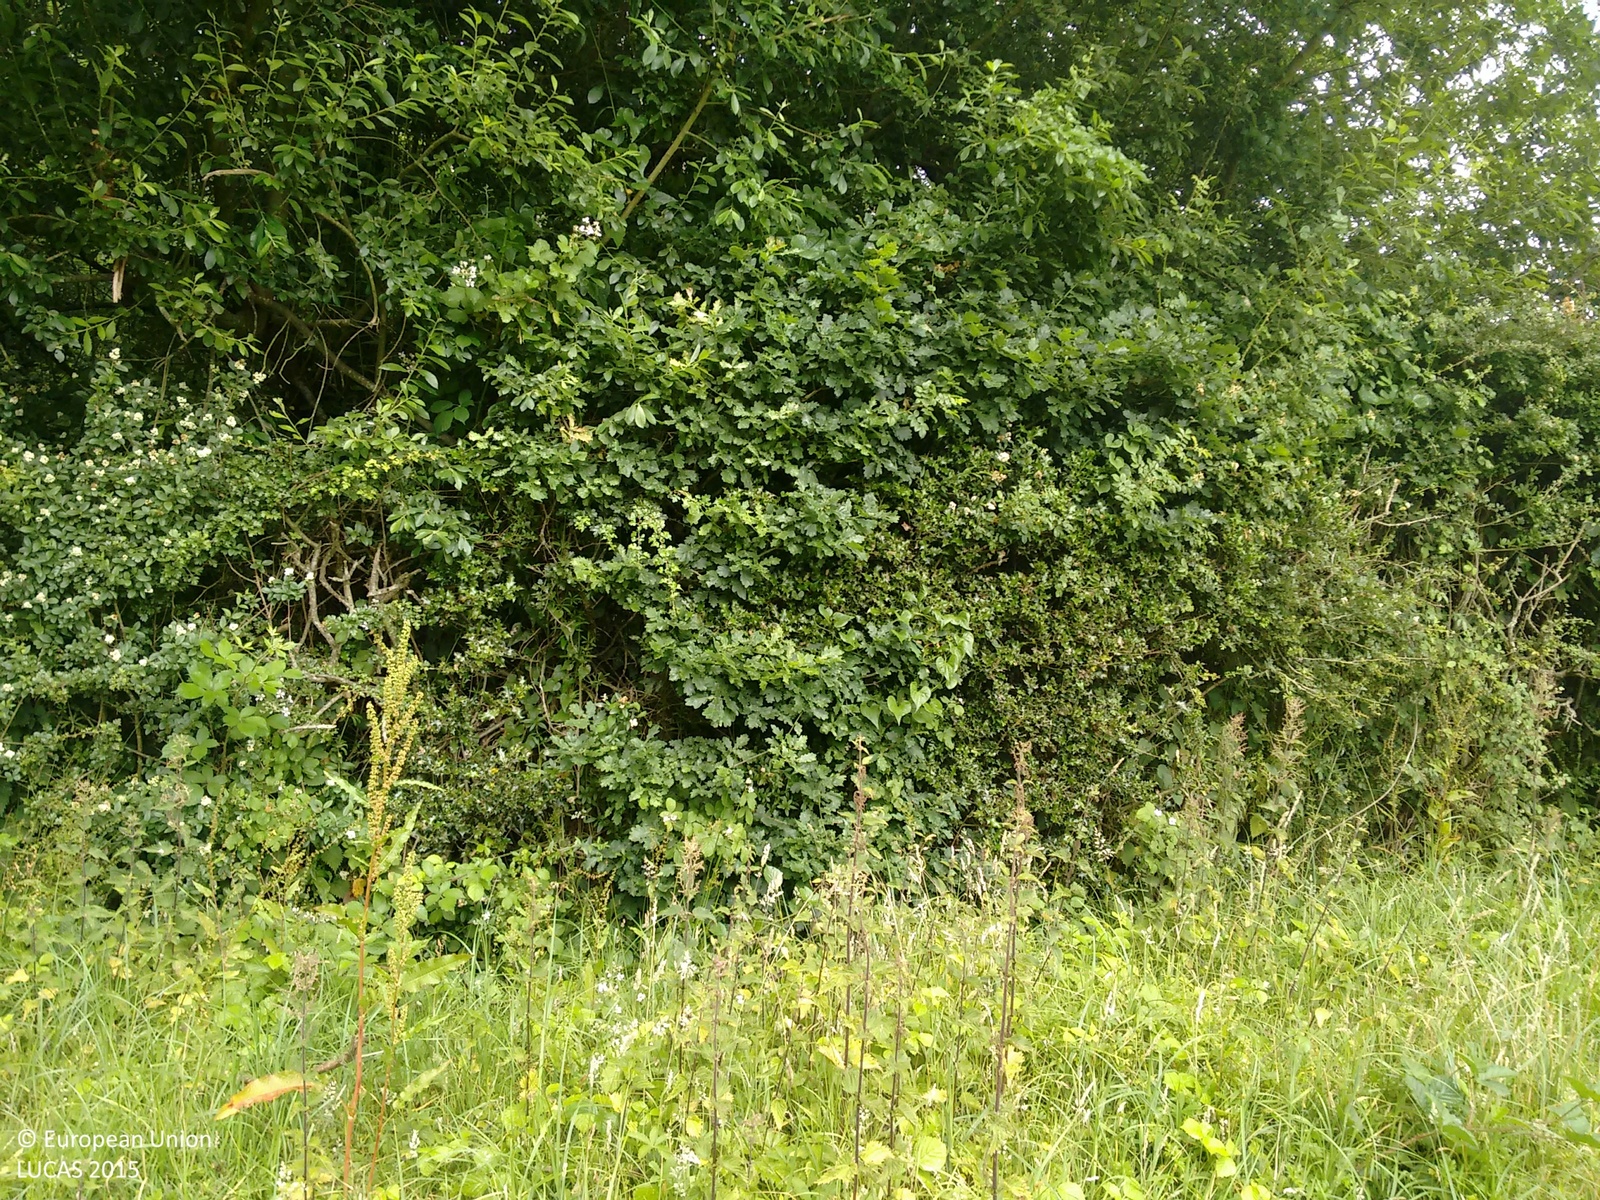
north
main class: Grassland
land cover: Grassland without tree/shrub cover
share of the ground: > 75 %
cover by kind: herbaceous plants 100 %
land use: Agriculture (excluding fallow land and kitchen gardens)
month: July
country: GB
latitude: 51.0331
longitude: -0.1734
